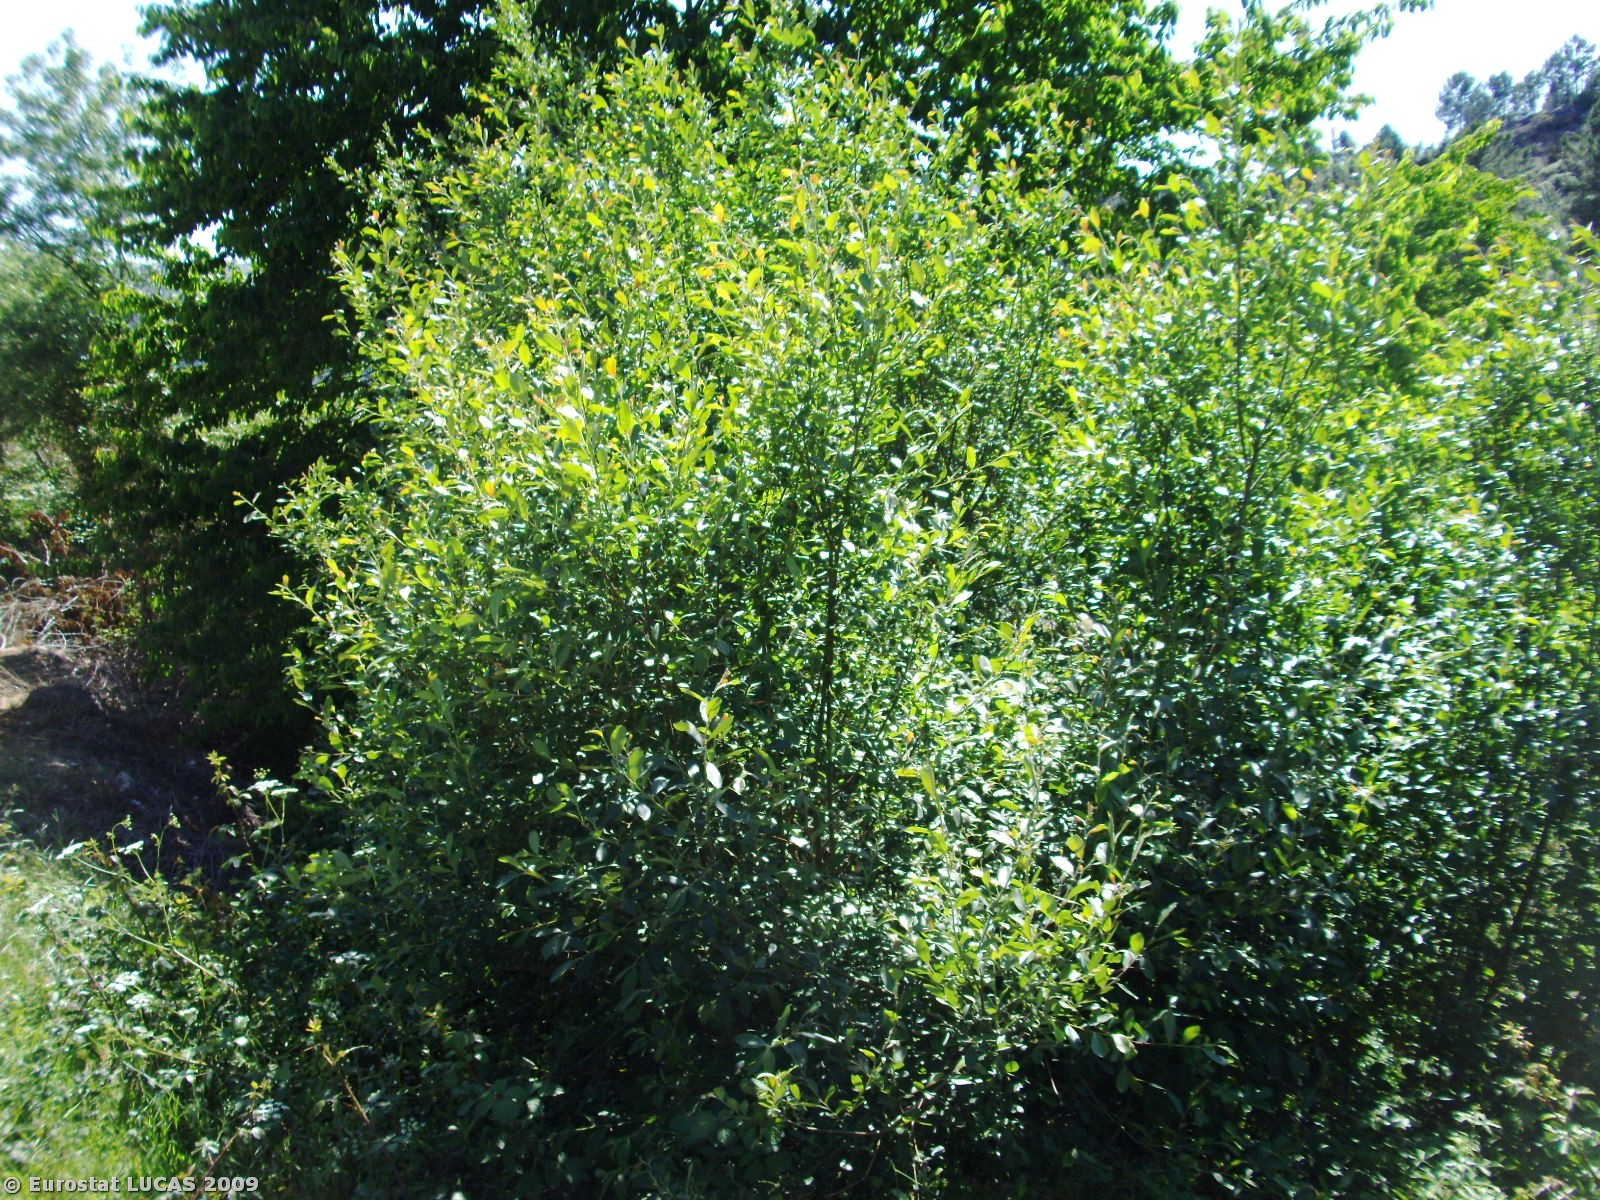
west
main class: Woodland
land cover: Coniferous woodland
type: coniferous forest of the mediterranean region
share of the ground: 25 - 50 %
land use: Forestry
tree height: > 5 m
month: May
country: PT
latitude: 41.0961
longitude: -7.6134
